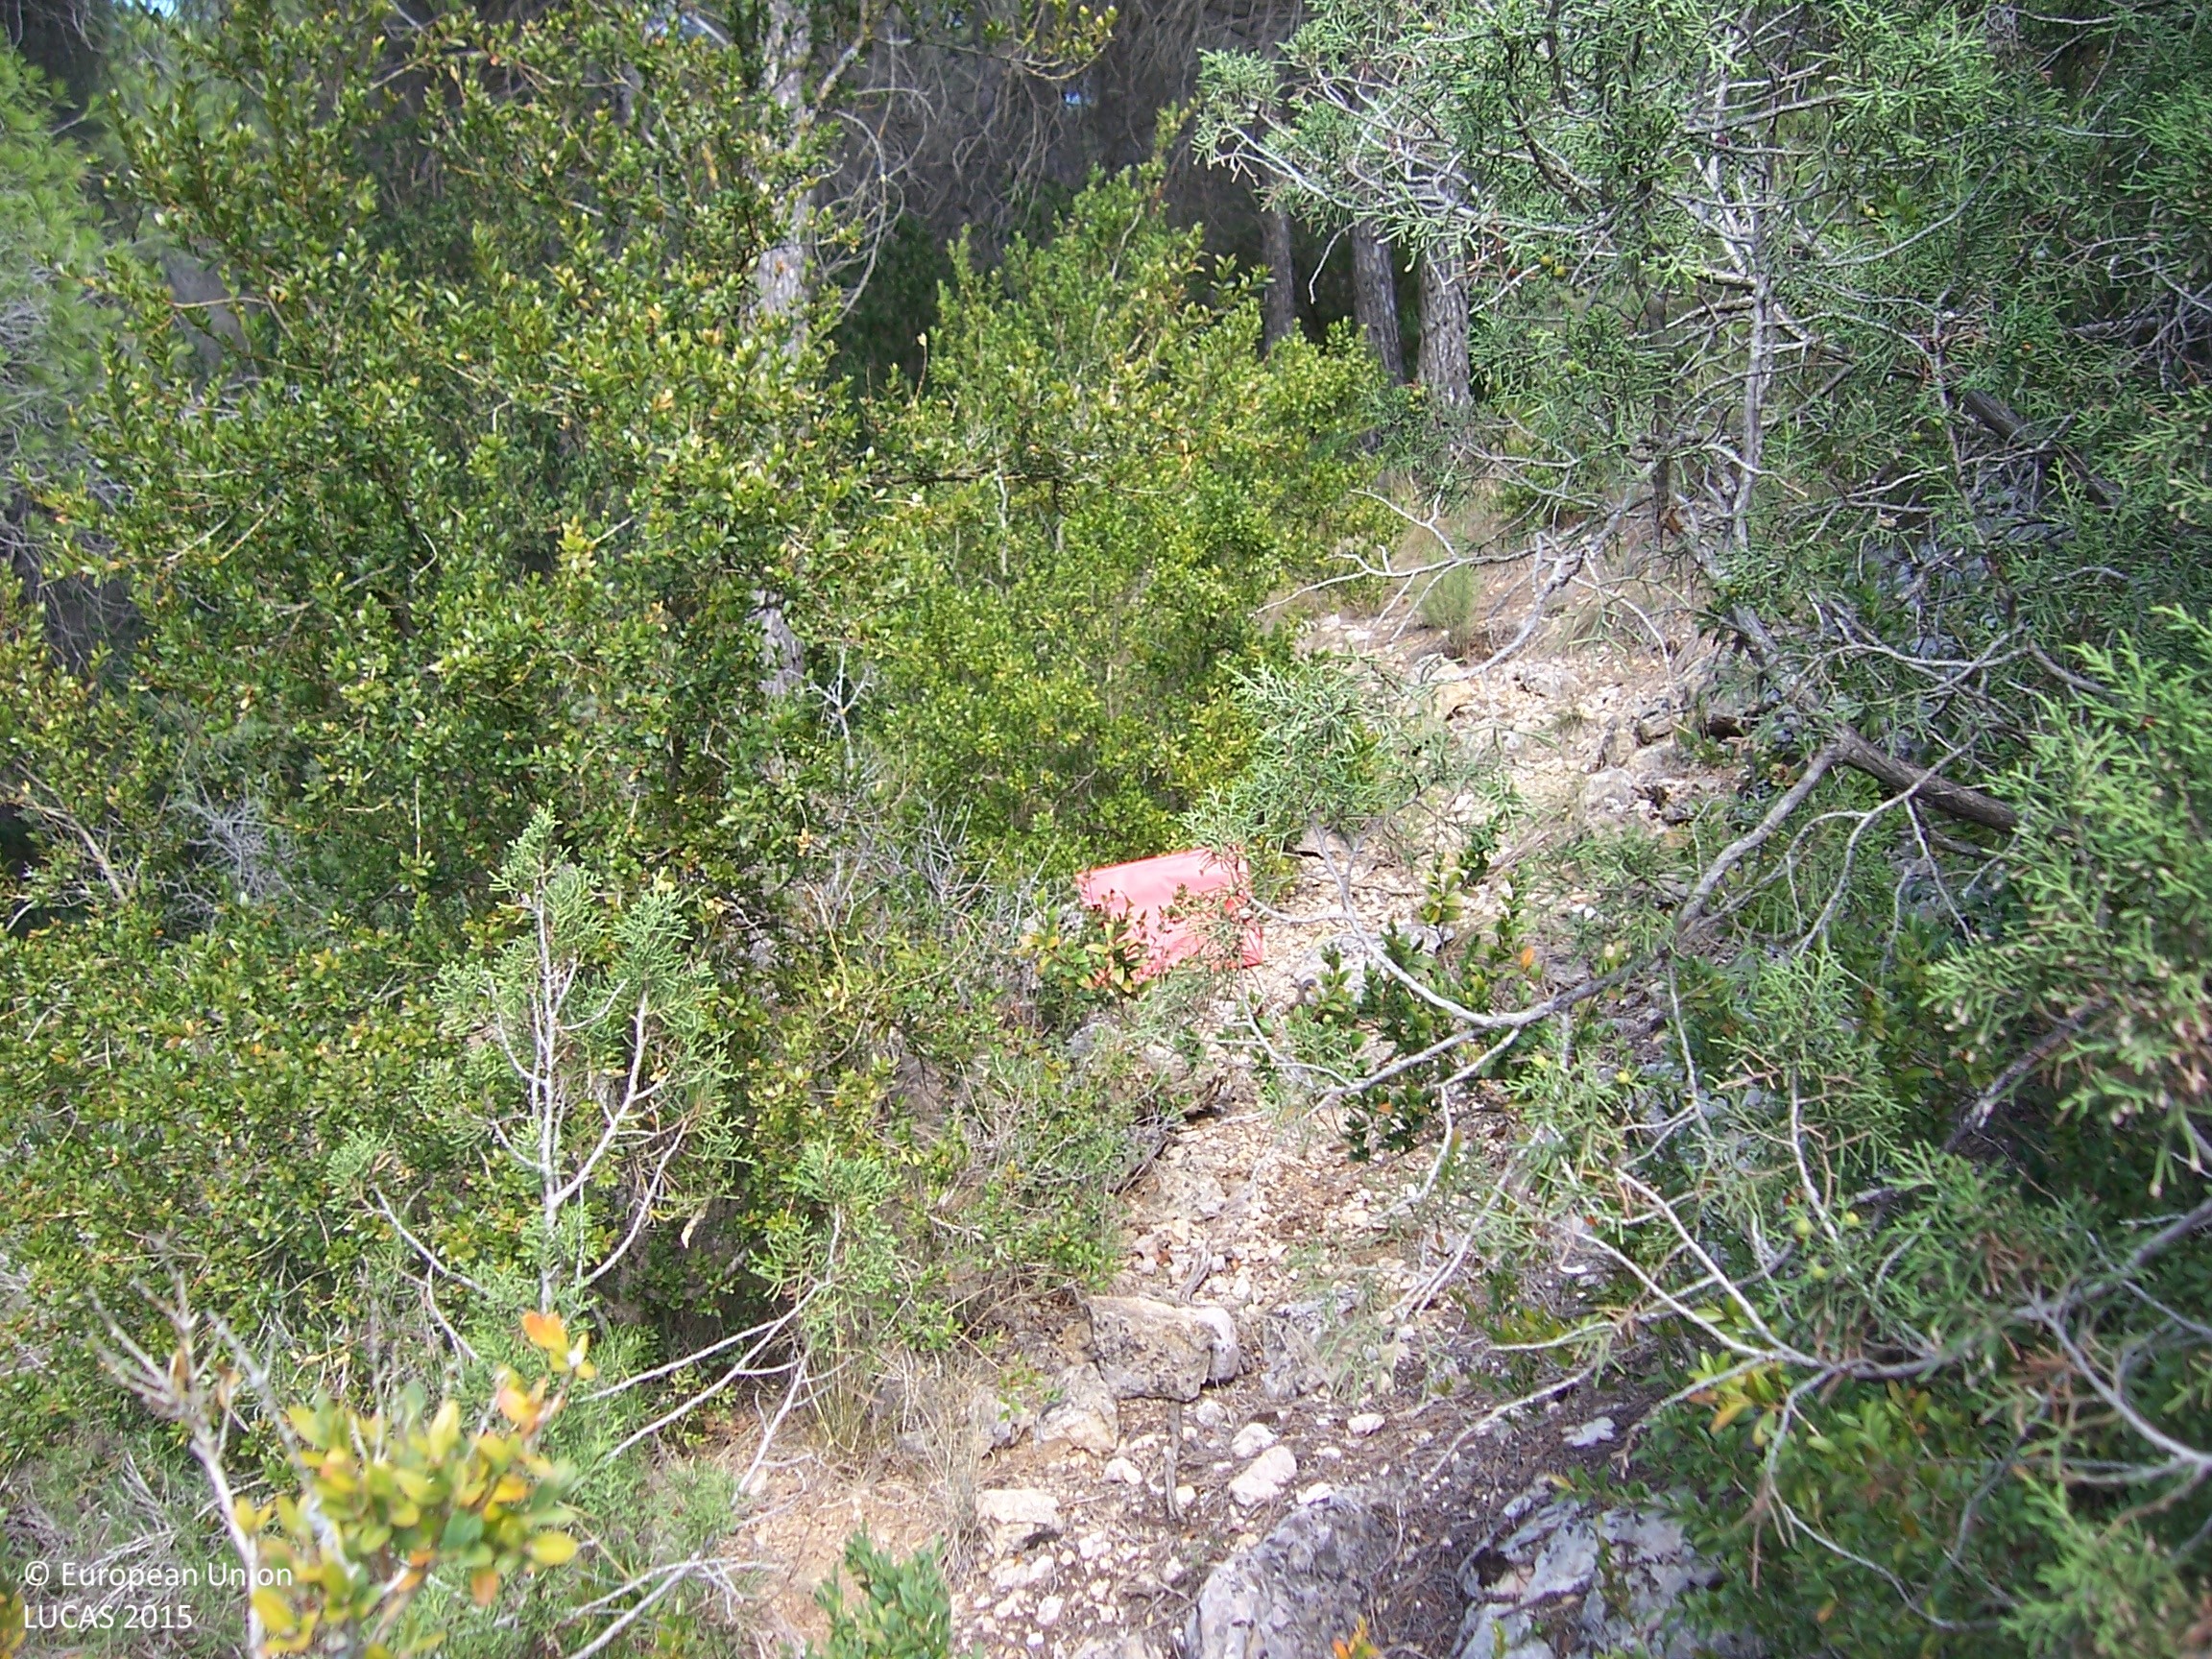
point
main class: Woodland
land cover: Pine dominated coniferous woodland
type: coniferous forest of the mediterranean region
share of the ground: > 75 %
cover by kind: coniferous forest trees 80 %, shrubs 20 %
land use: Forestry
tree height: > 5 m
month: August
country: ES
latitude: 42.0068
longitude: 0.3117
